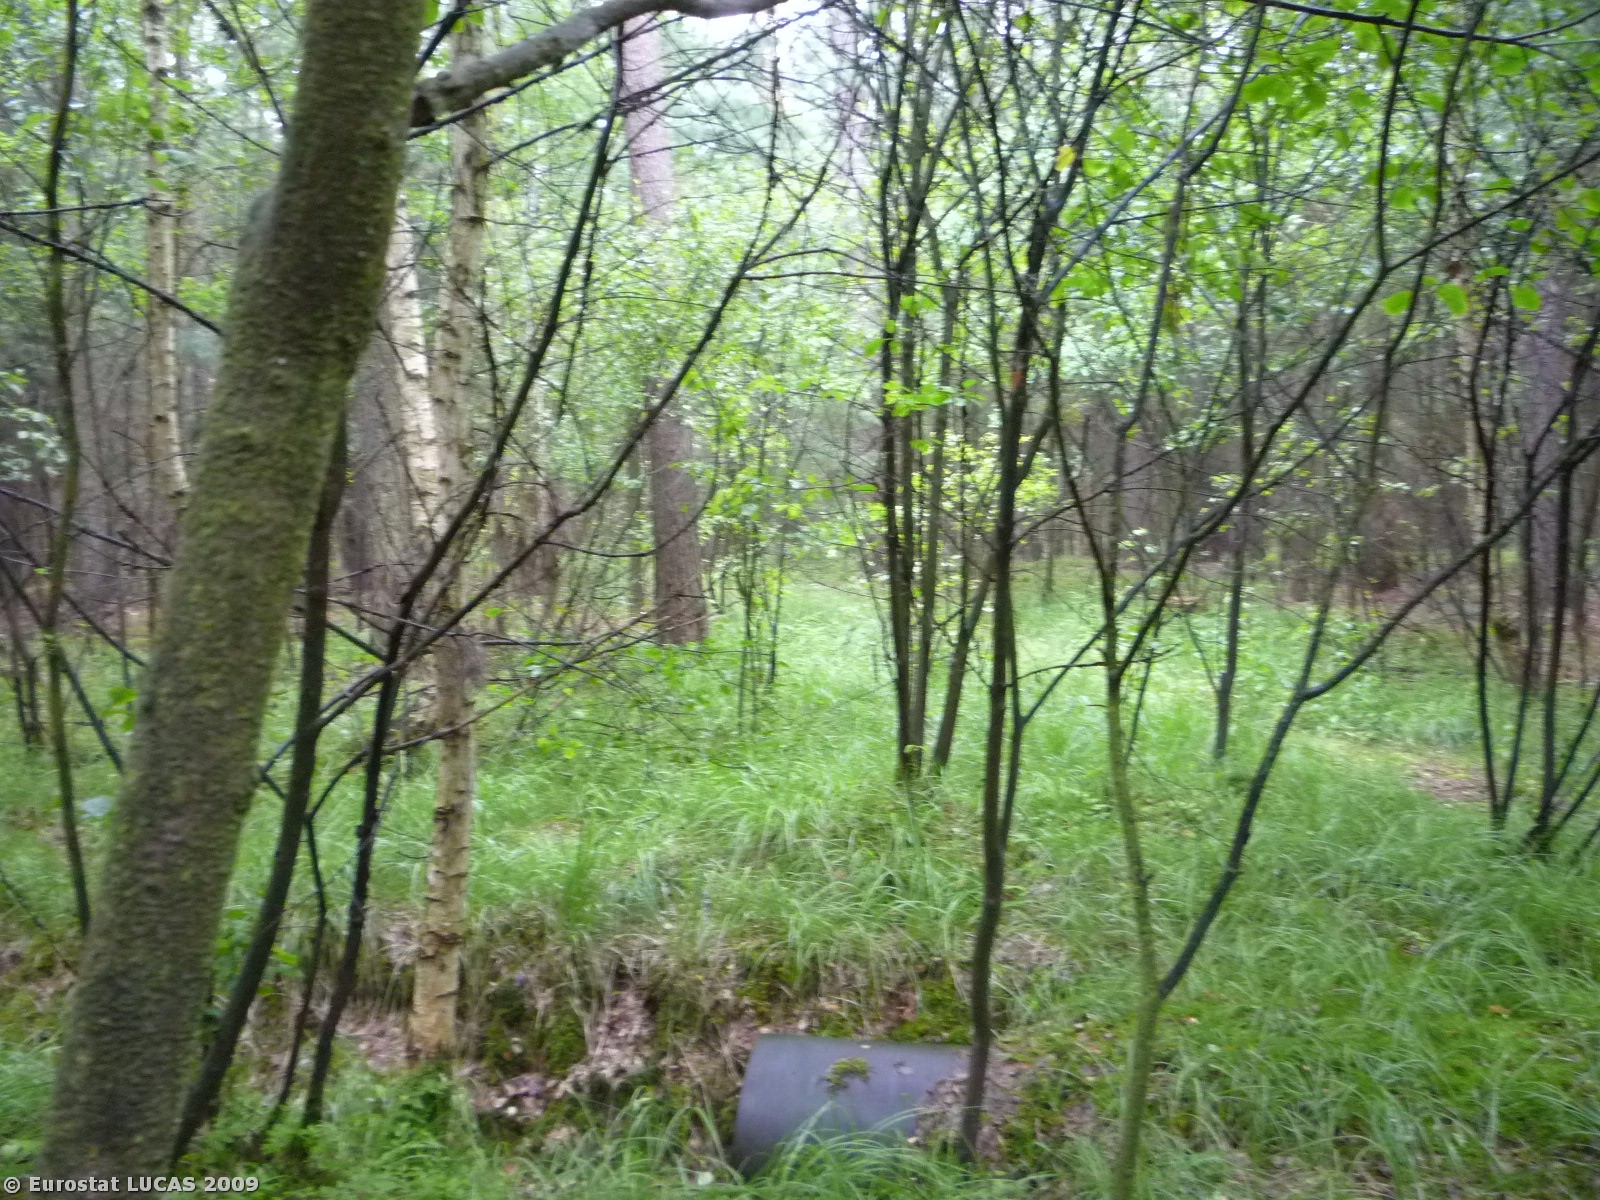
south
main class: Woodland
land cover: Mixed woodland
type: hemiboreal forest and nemoral coniferous forest and mixed broadleaved-coniferous forest
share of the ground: > 75 %
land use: Forestry
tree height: > 5 m
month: June
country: CZ
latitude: 50.0725
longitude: 15.4390
